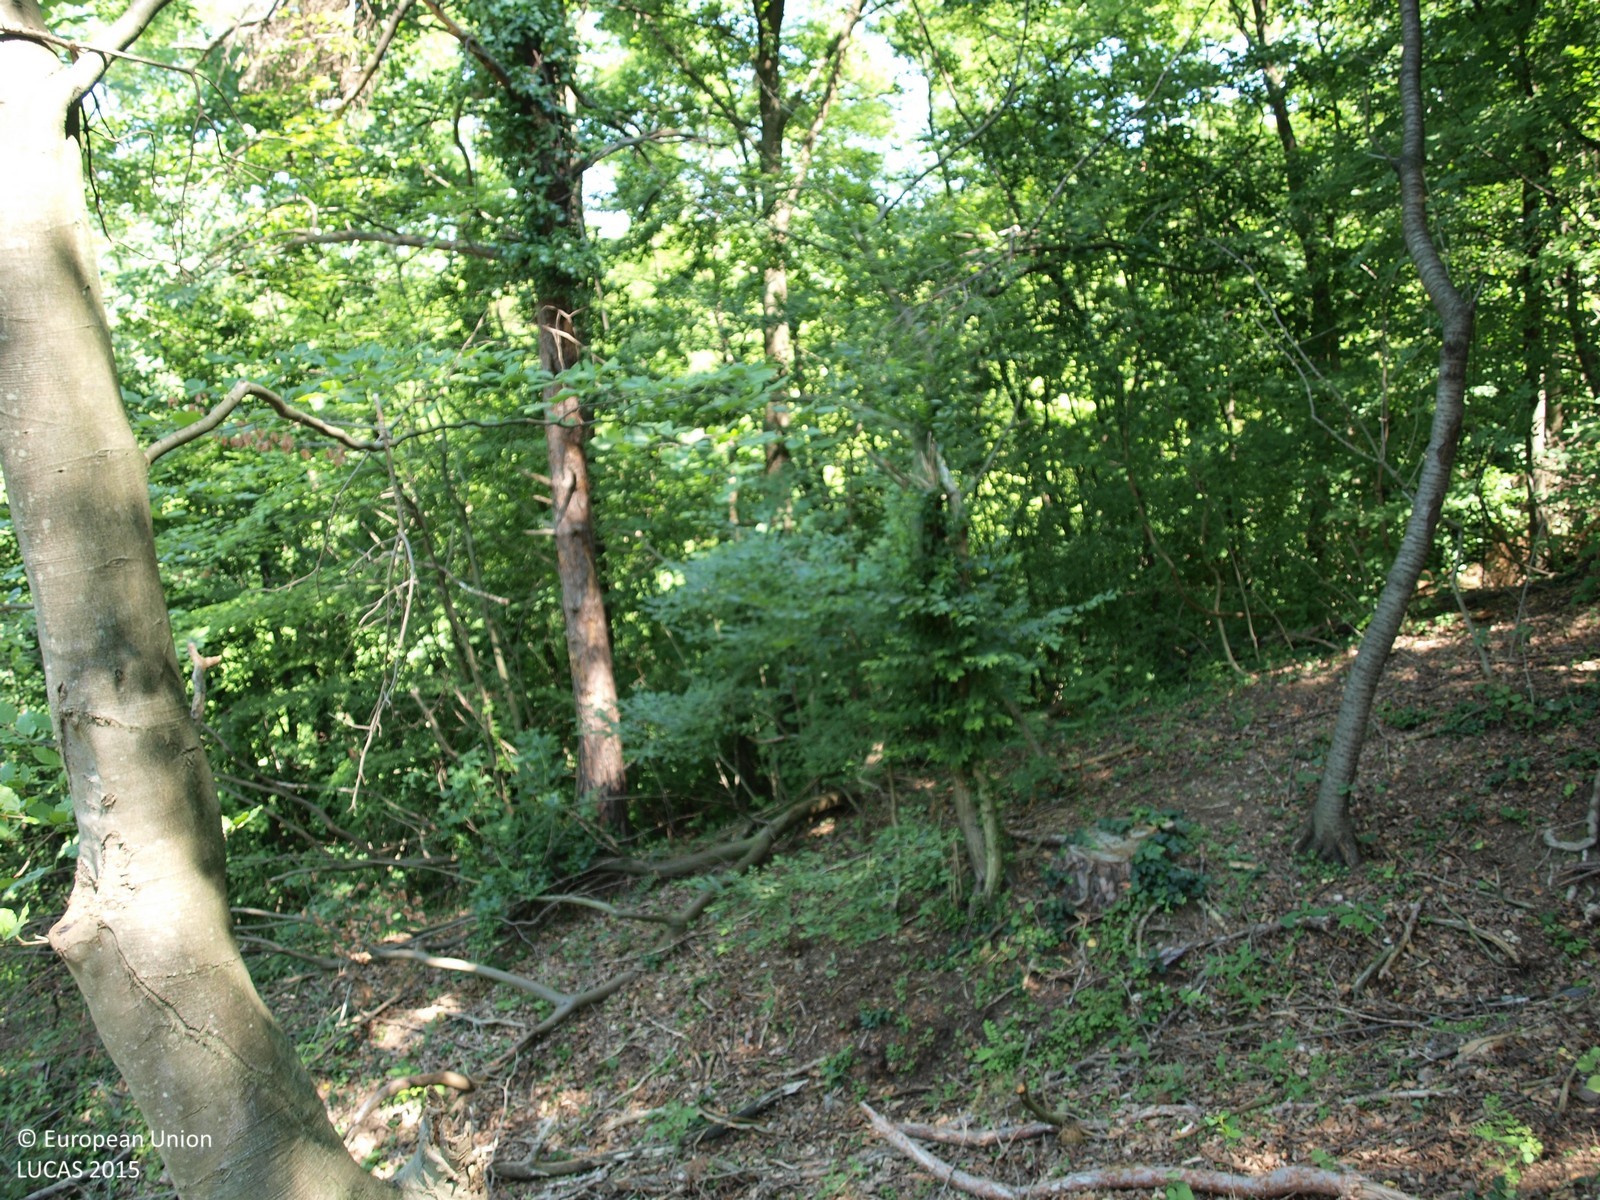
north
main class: Woodland
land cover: Broadleaved woodland
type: beech forest
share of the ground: > 75 %
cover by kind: broadleaved forest trees 100 %
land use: Forestry
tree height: > 5 m
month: July
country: HR
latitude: 46.0587
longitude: 15.9574
